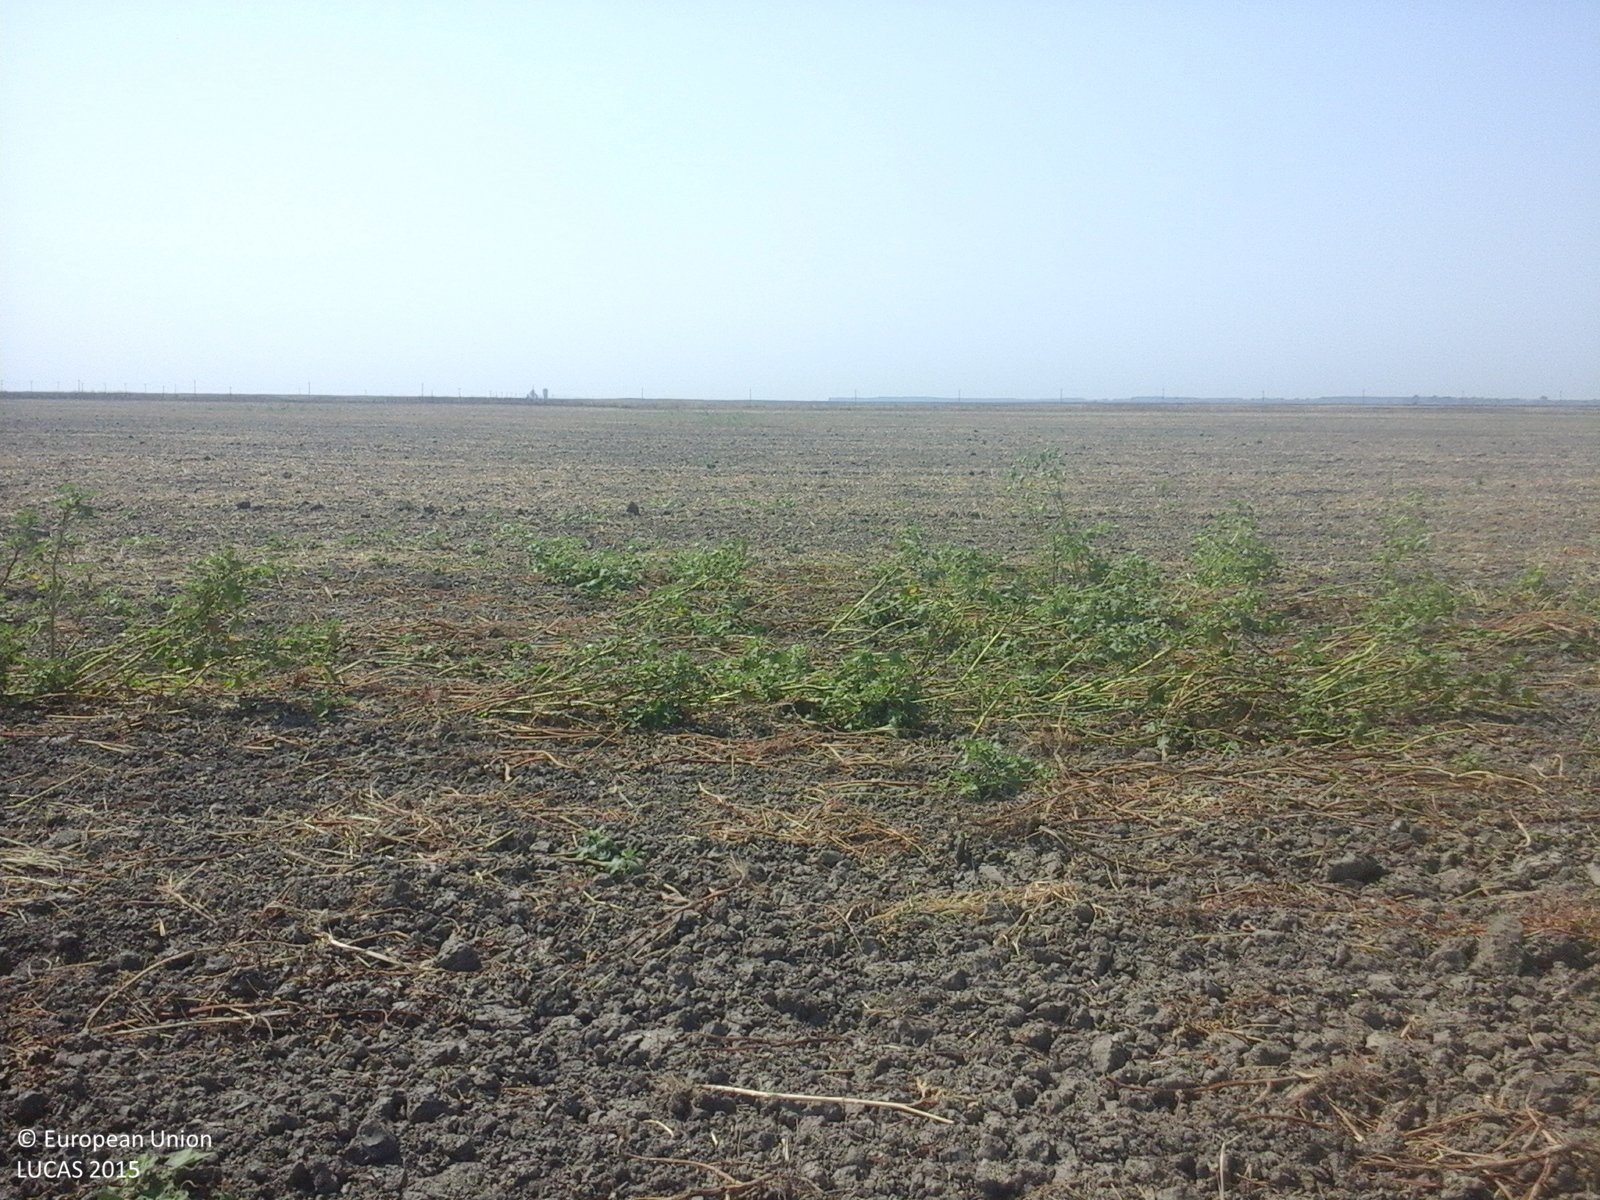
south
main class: Cropland
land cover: Common wheat
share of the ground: < 10 %
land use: Agriculture (excluding fallow land and kitchen gardens)
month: August
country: RO
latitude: 44.9991
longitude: 27.9603
